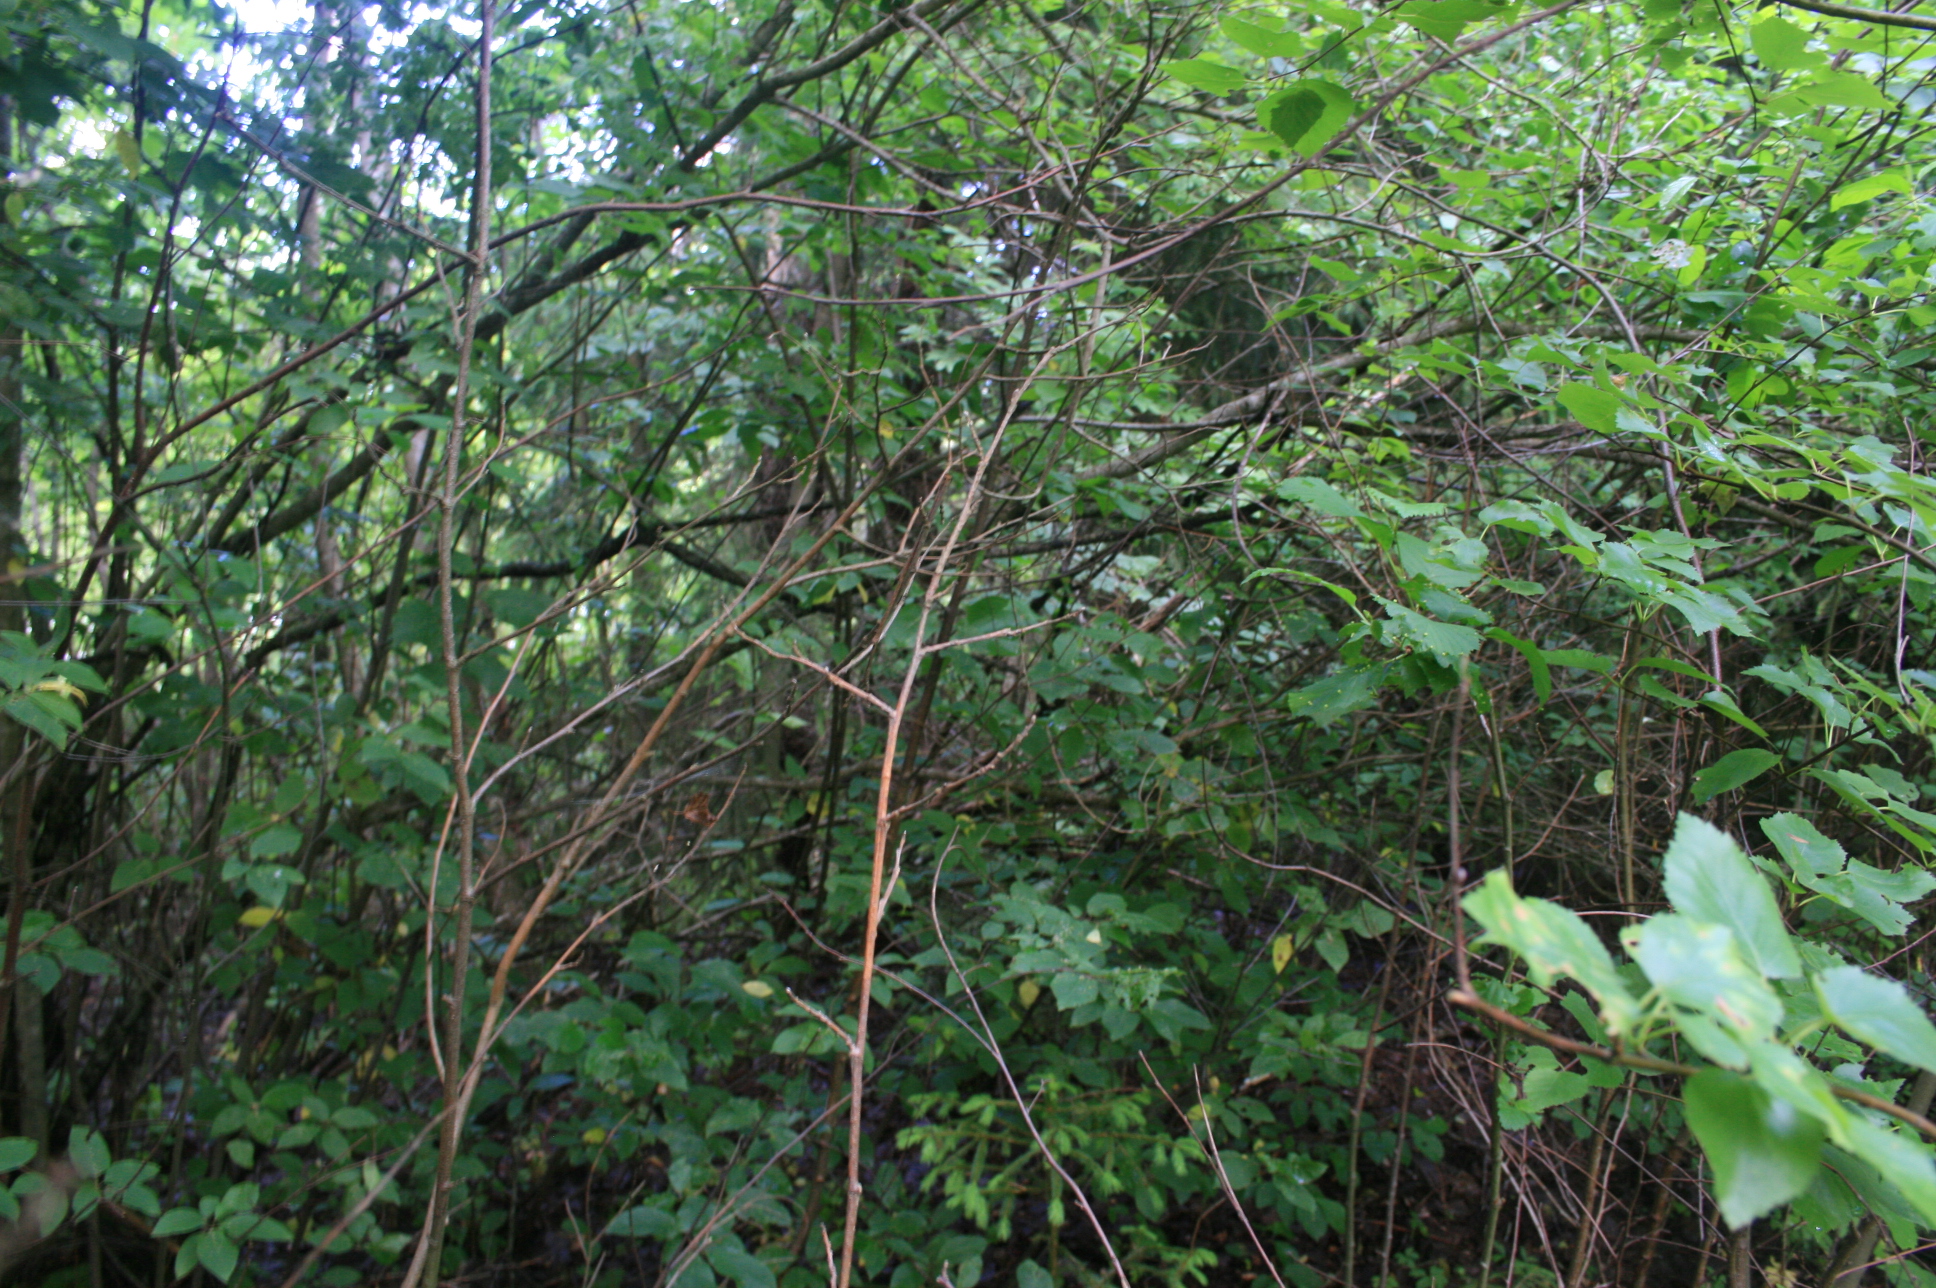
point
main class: Woodland
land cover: Spruce dominated mixed woodland
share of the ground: > 75 %
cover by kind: broadleaved forest trees 70 %, coniferous forest trees 30 %
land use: Forestry
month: June
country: LT
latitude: 55.4794
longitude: 22.1598
